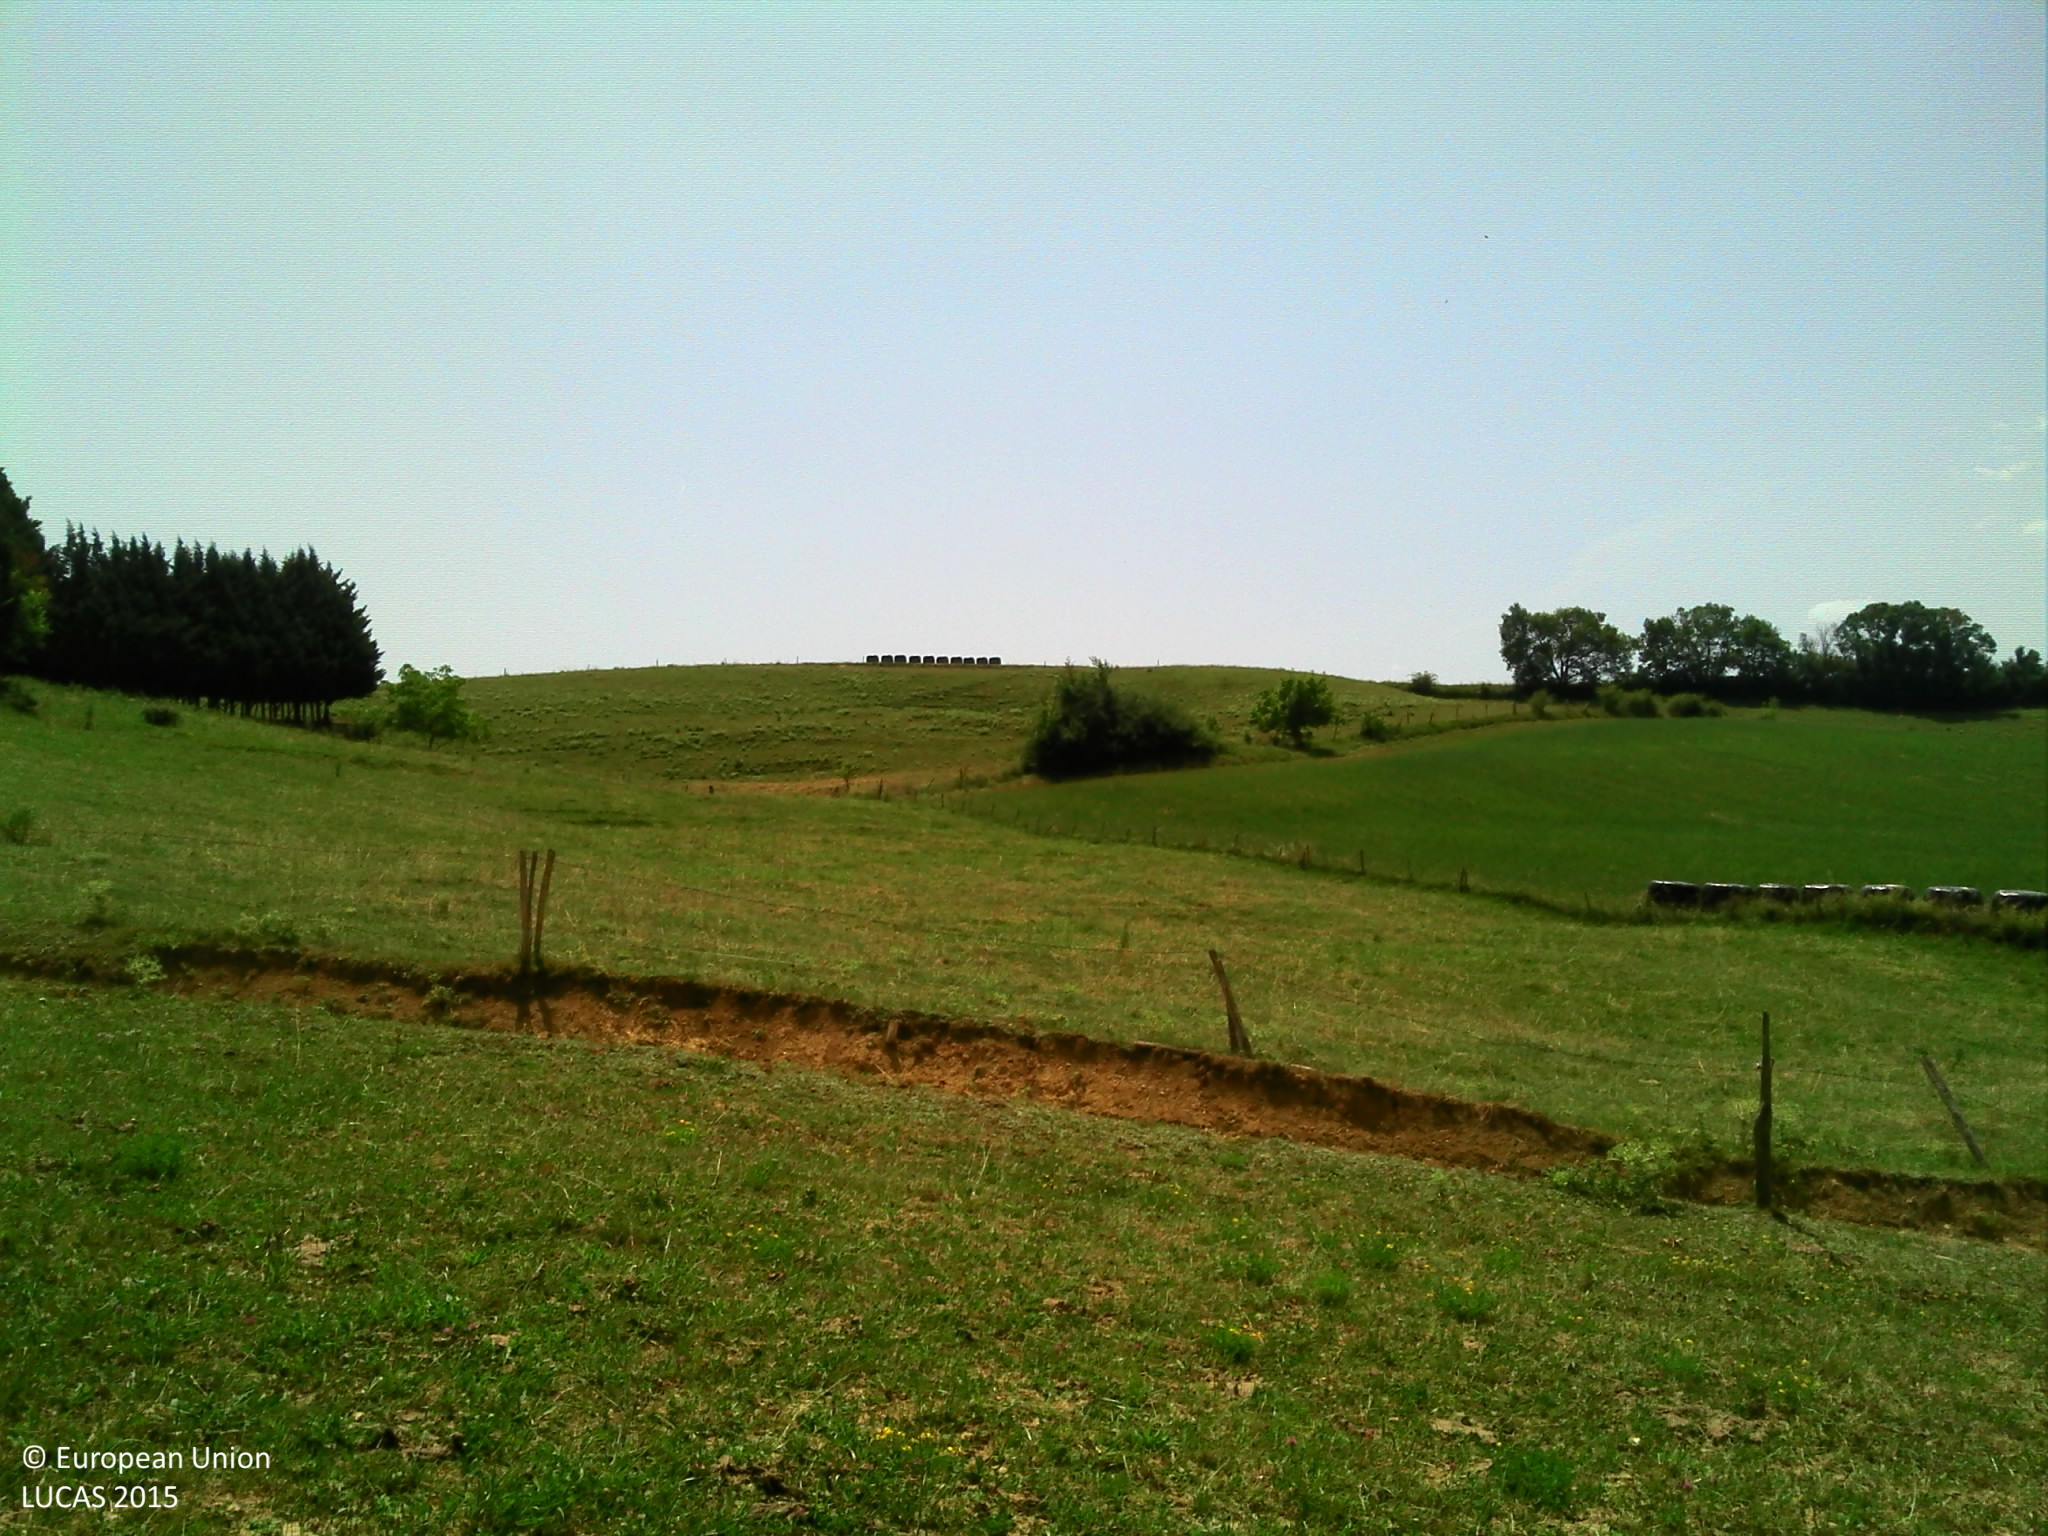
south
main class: Grassland
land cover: Grassland without tree/shrub cover
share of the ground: > 75 %
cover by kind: herbaceous plants 100 %
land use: Agriculture (excluding fallow land and kitchen gardens)
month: July
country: FR
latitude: 43.1236
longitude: 1.4135
